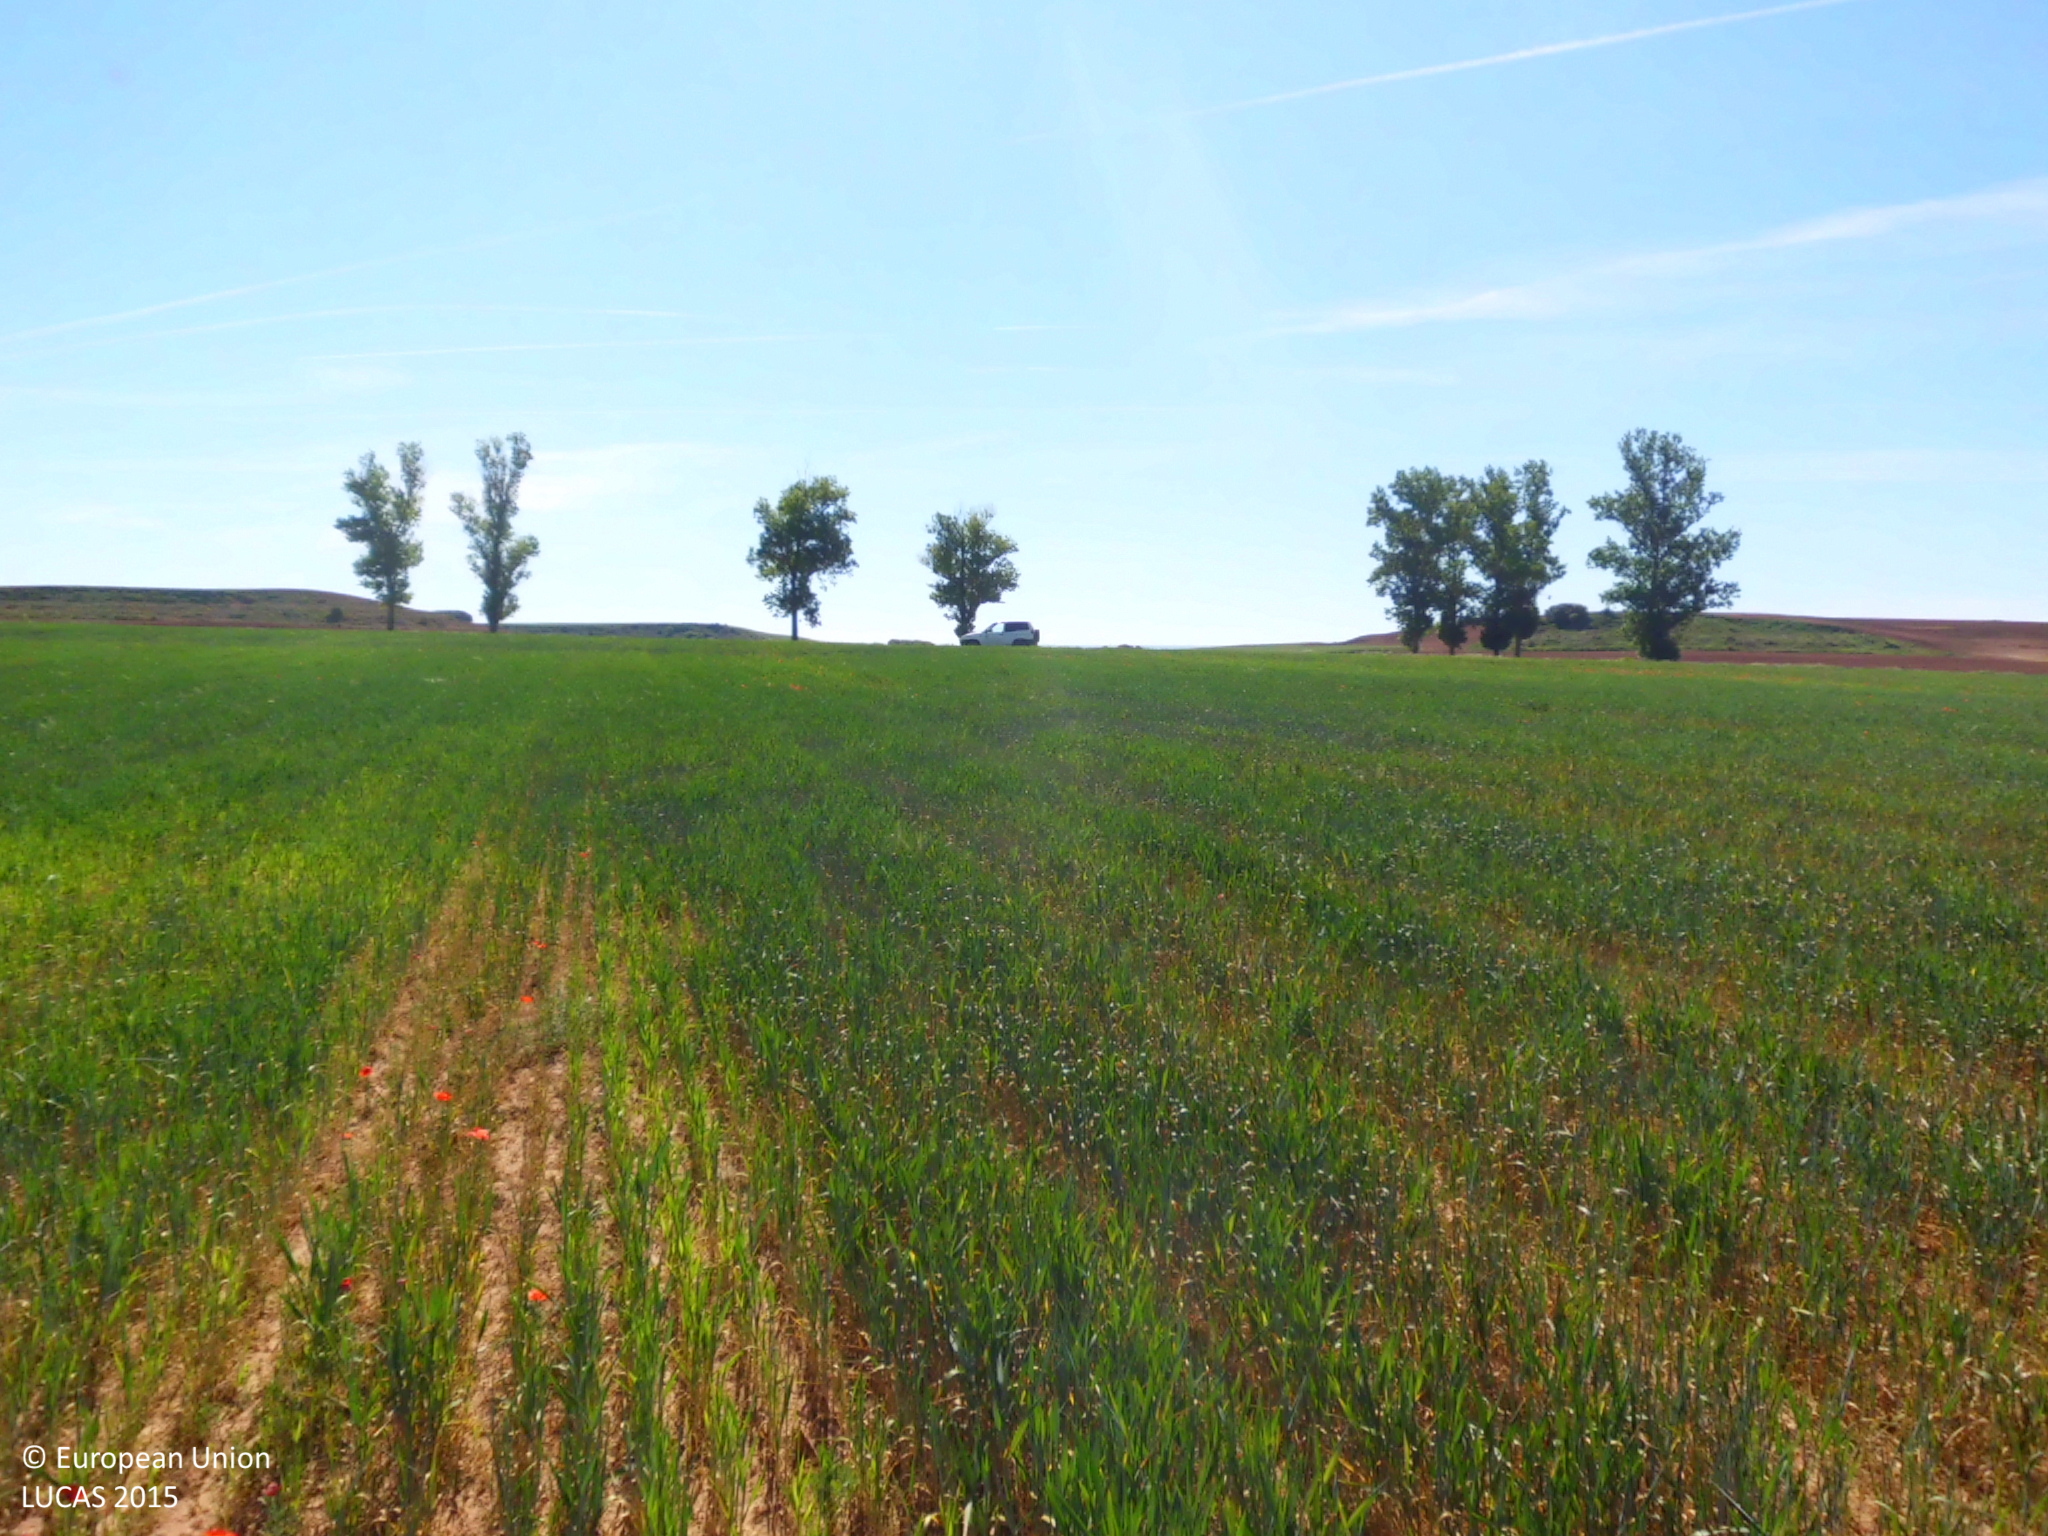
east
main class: Cropland
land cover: Common wheat
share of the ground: 25 - 50 %
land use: Agriculture (excluding fallow land and kitchen gardens)
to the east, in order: Common wheat; Tracks; Sunflower; Groves; Sunflower
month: May
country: ES
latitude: 42.6349
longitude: -3.4126
